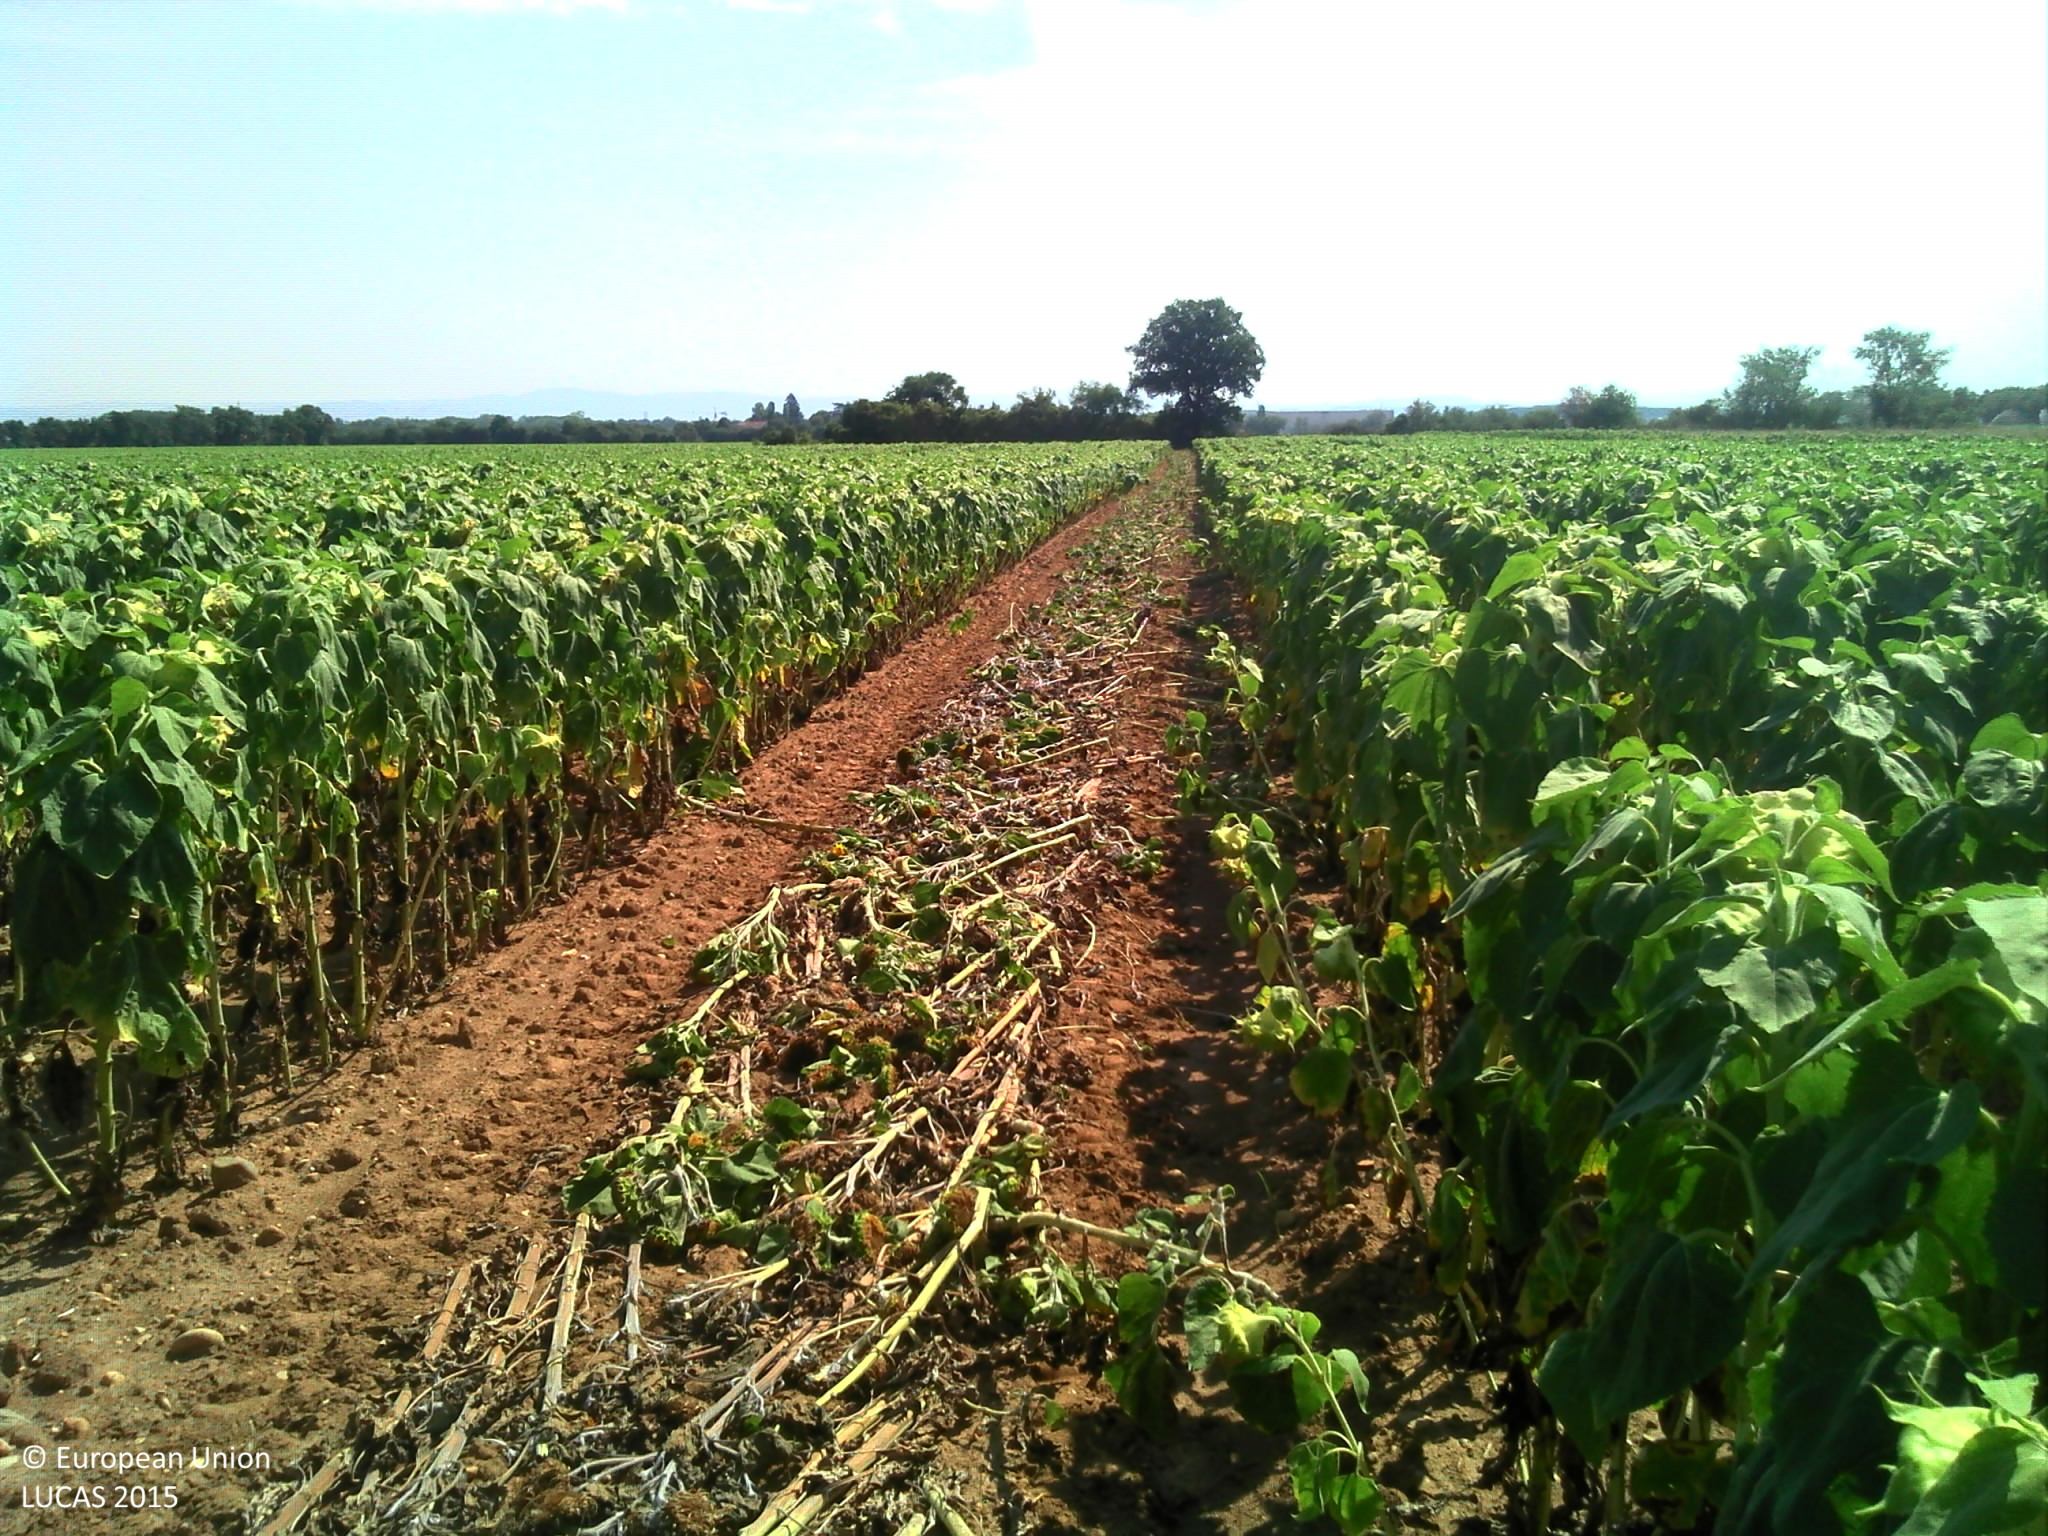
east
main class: Cropland
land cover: Sunflower
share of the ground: > 75 %
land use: Agriculture (excluding fallow land and kitchen gardens)
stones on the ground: 25 - 50 %
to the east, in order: Sunflower; Tracks; Grassland without tree/shrub cover; Grass margins; Other fresh vegetables
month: August
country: FR
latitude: 45.7676
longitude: 5.0532
